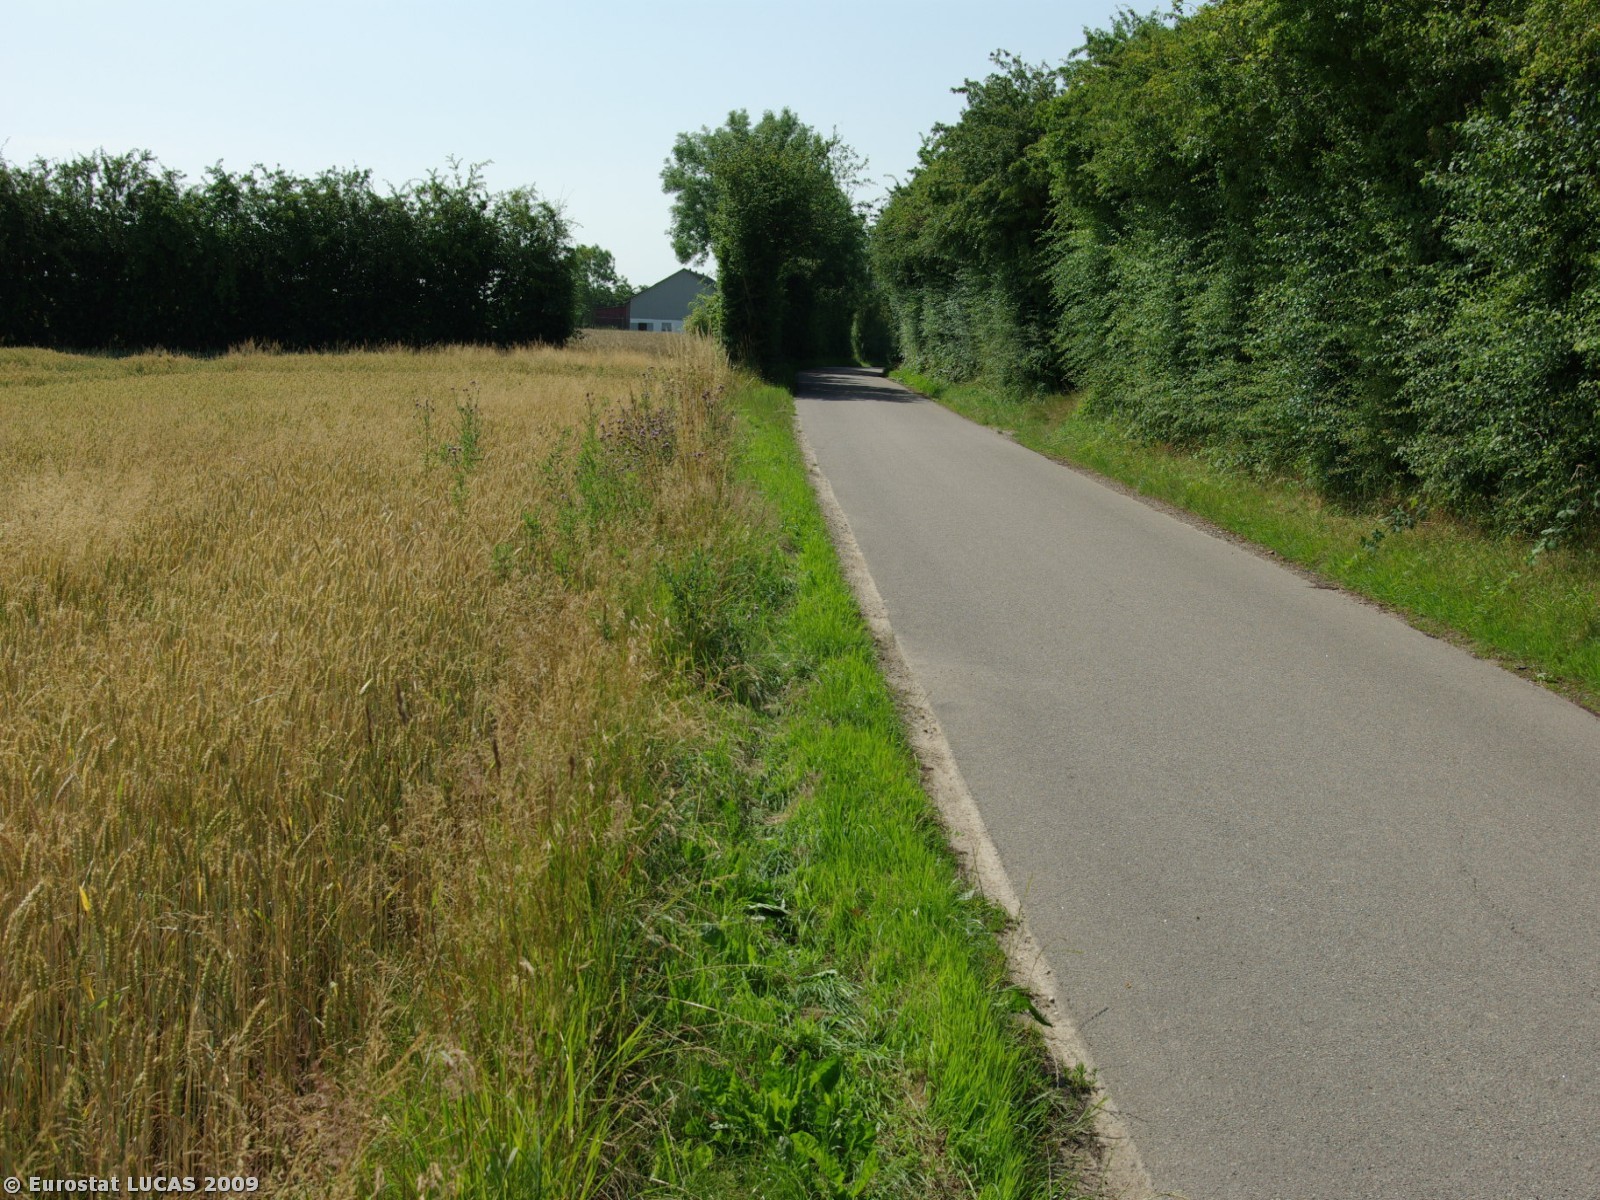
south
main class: Cropland
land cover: Common wheat
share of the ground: > 75 %
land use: Agriculture (excluding fallow land and kitchen gardens)
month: July
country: DK
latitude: 54.9652
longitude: 9.7347
